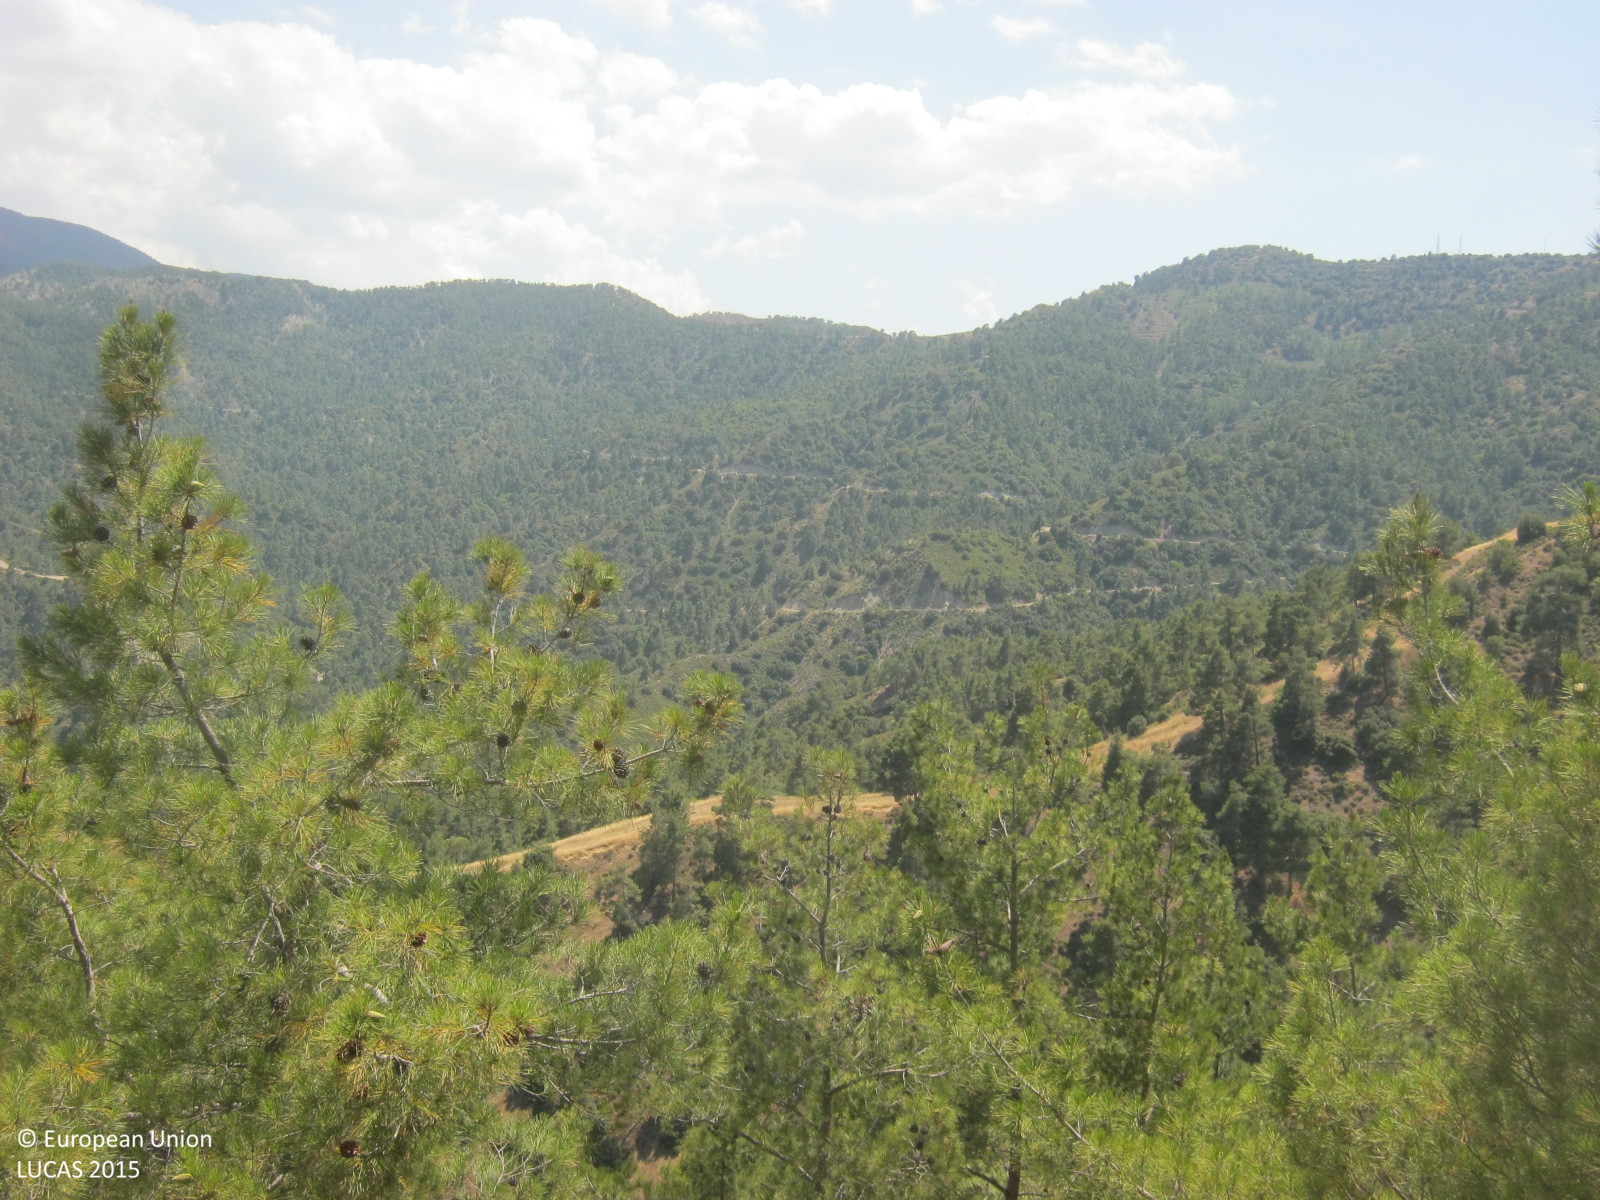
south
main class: Woodland
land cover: Pine dominated coniferous woodland
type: coniferous forest of the mediterranean region
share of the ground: 25 - 50 %
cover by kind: coniferous forest trees 50 %, shrubs 20 %, herbaceous plants 15 %, unconsolidated bare surface 15 %
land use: Forestry
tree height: > 5 m
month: June
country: CY
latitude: 35.0159
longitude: 32.8650
